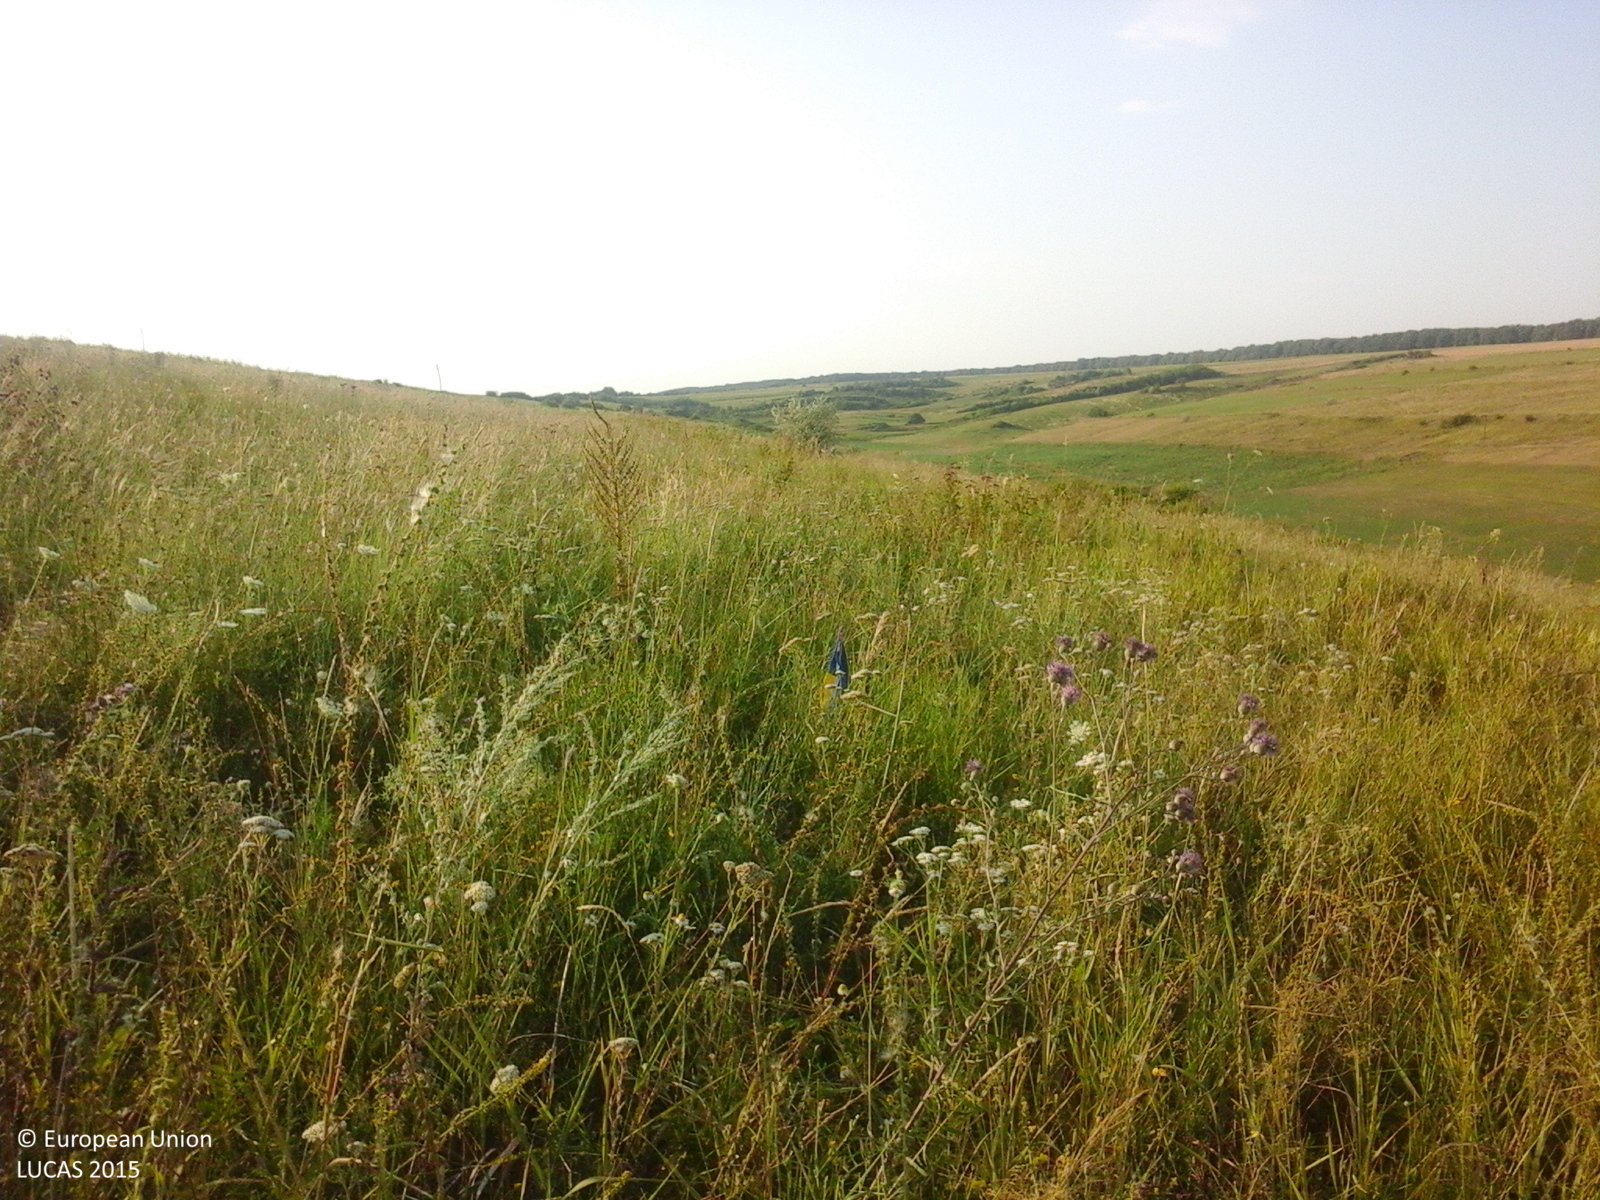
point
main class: Grassland
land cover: Grassland without tree/shrub cover
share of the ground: > 75 %
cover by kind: herbaceous plants 100 %
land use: Agriculture (excluding fallow land and kitchen gardens)
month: July
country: RO
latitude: 46.4217
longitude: 27.6142
